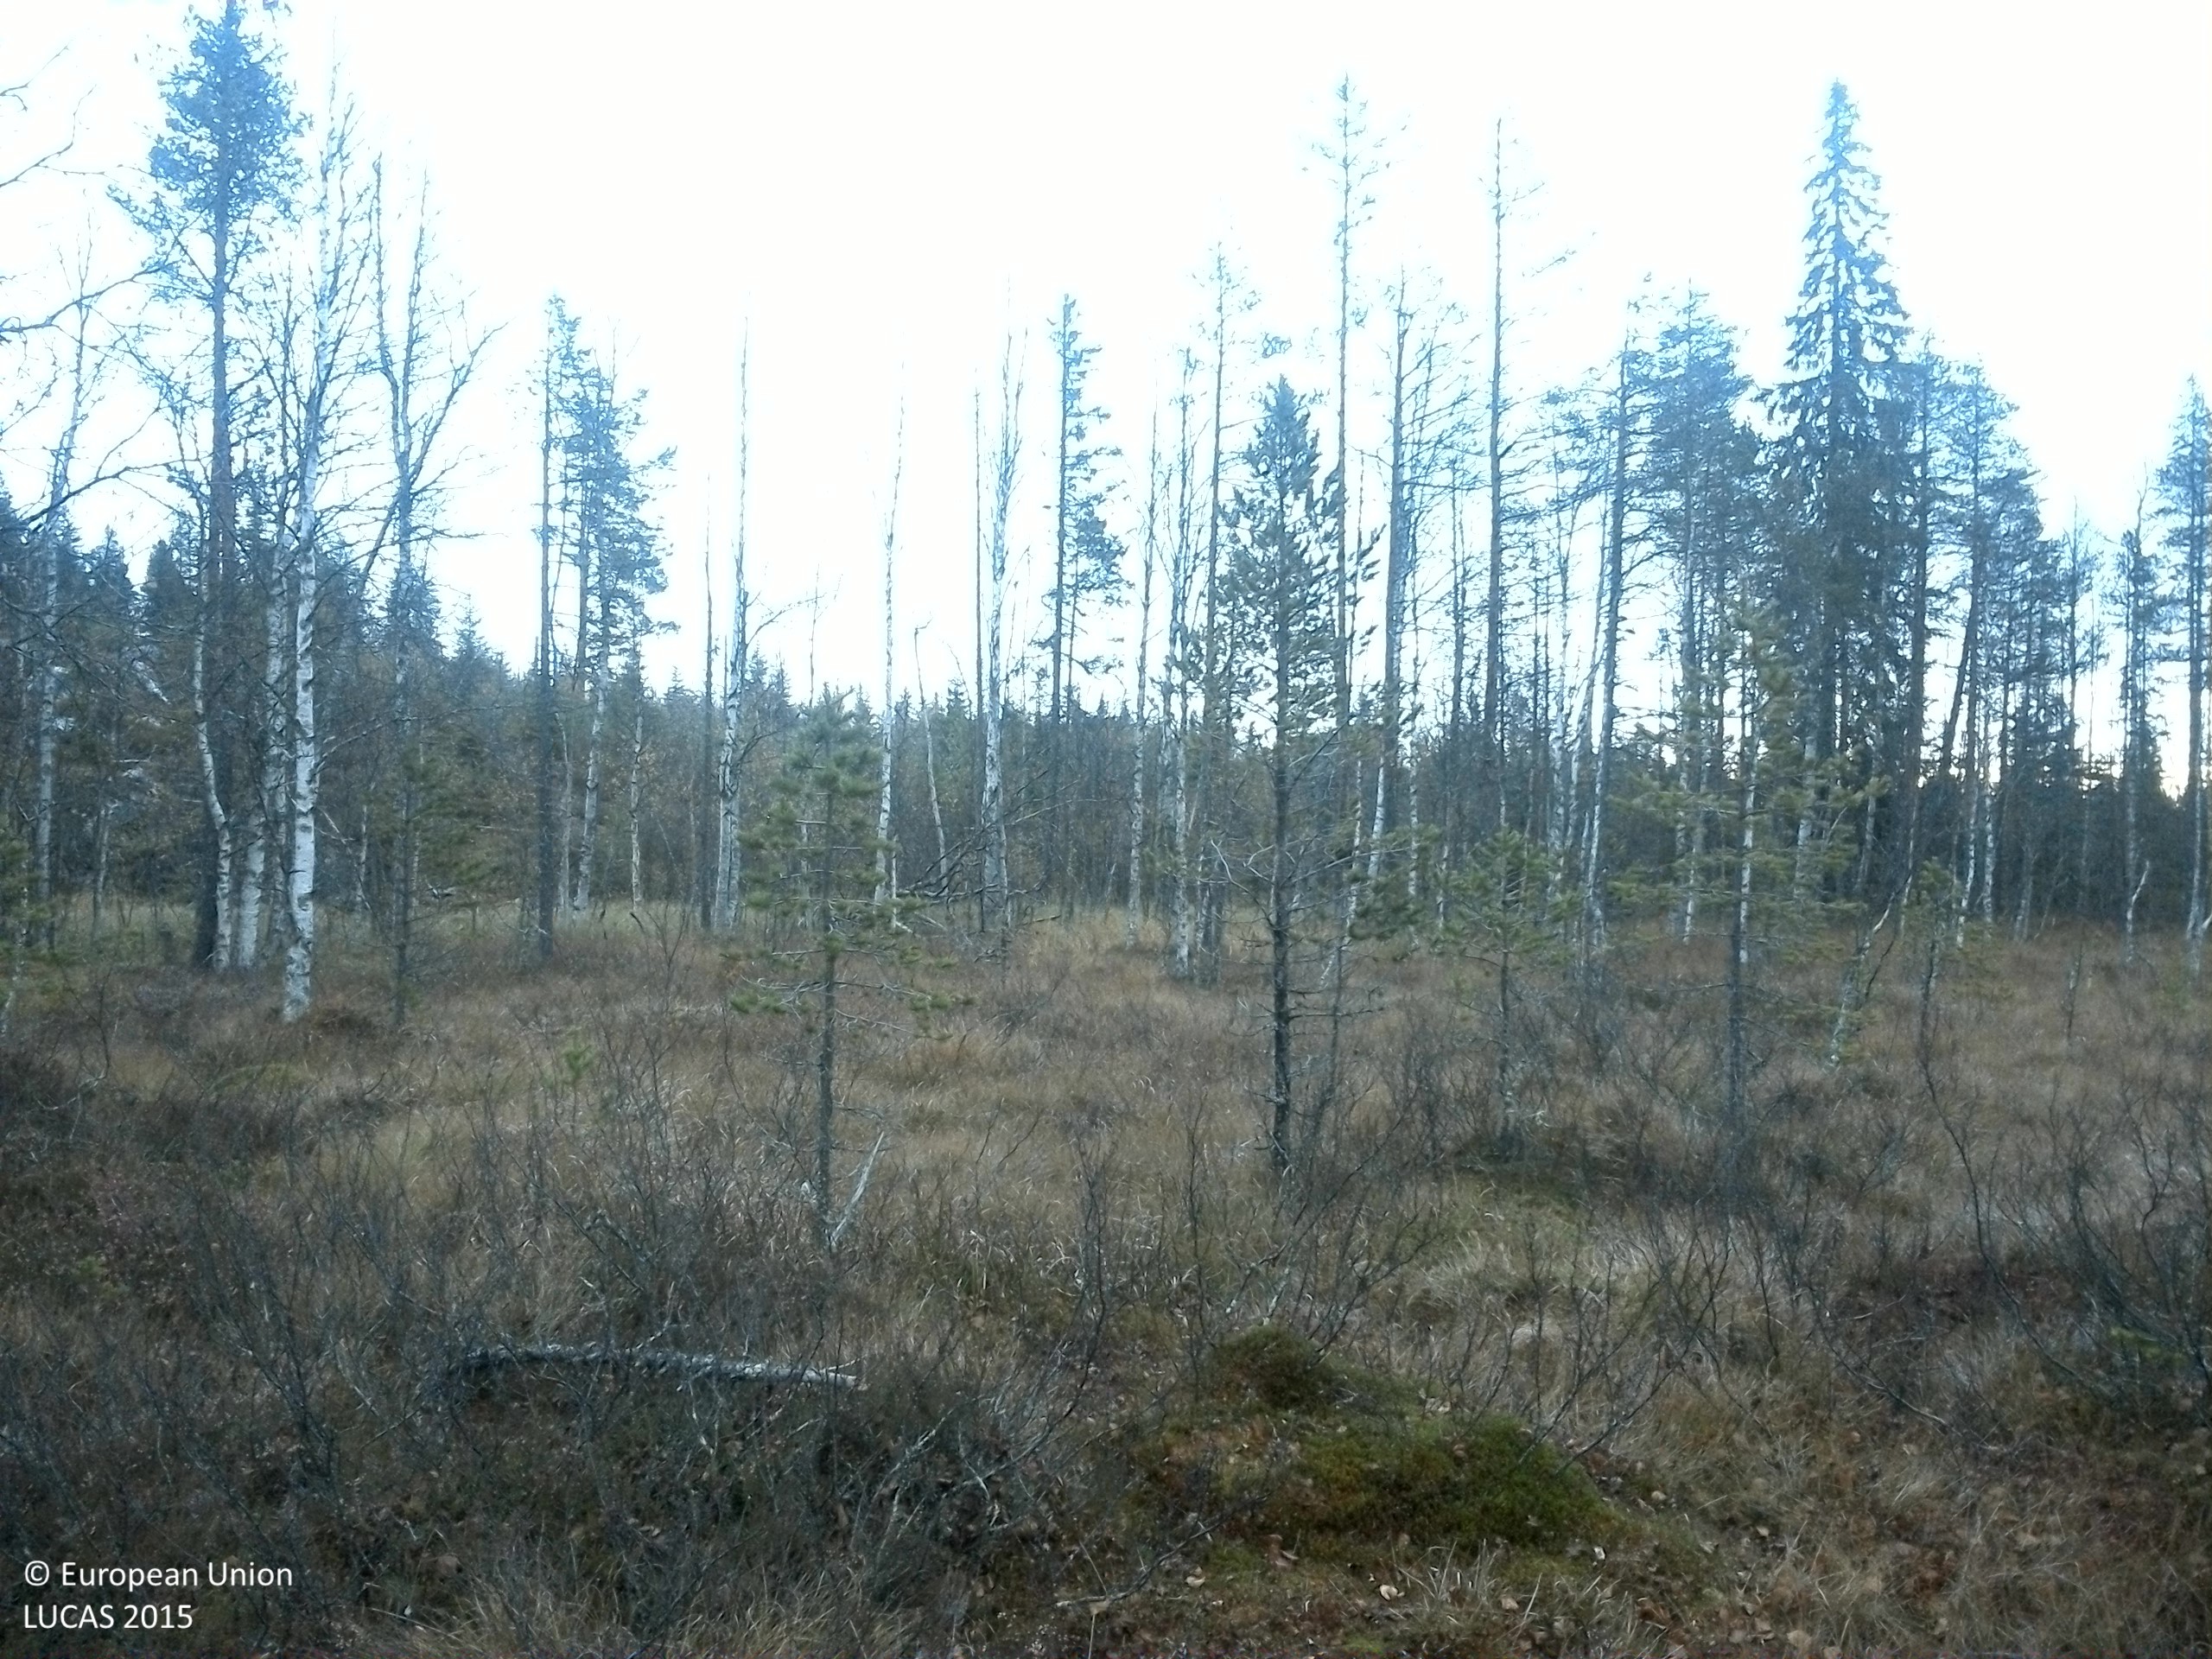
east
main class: Woodland
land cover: Pine dominated mixed woodland
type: mire and swamp forests
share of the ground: 10 - 25 %
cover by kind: shrubs 30 %, herbaceous plants 30 %, lichens and mosses 30 %, coniferous forest trees 5 %, broadleaved forest trees 5 %
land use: Semi-natural and natural areas not in use
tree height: < 5 m
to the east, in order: Pine dominated mixed woodland; Spruce dominated mixed woodland; Pine dominated coniferous woodland; Pine dominated mixed woodland
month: October
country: SE
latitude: 64.0667
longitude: 16.0171
